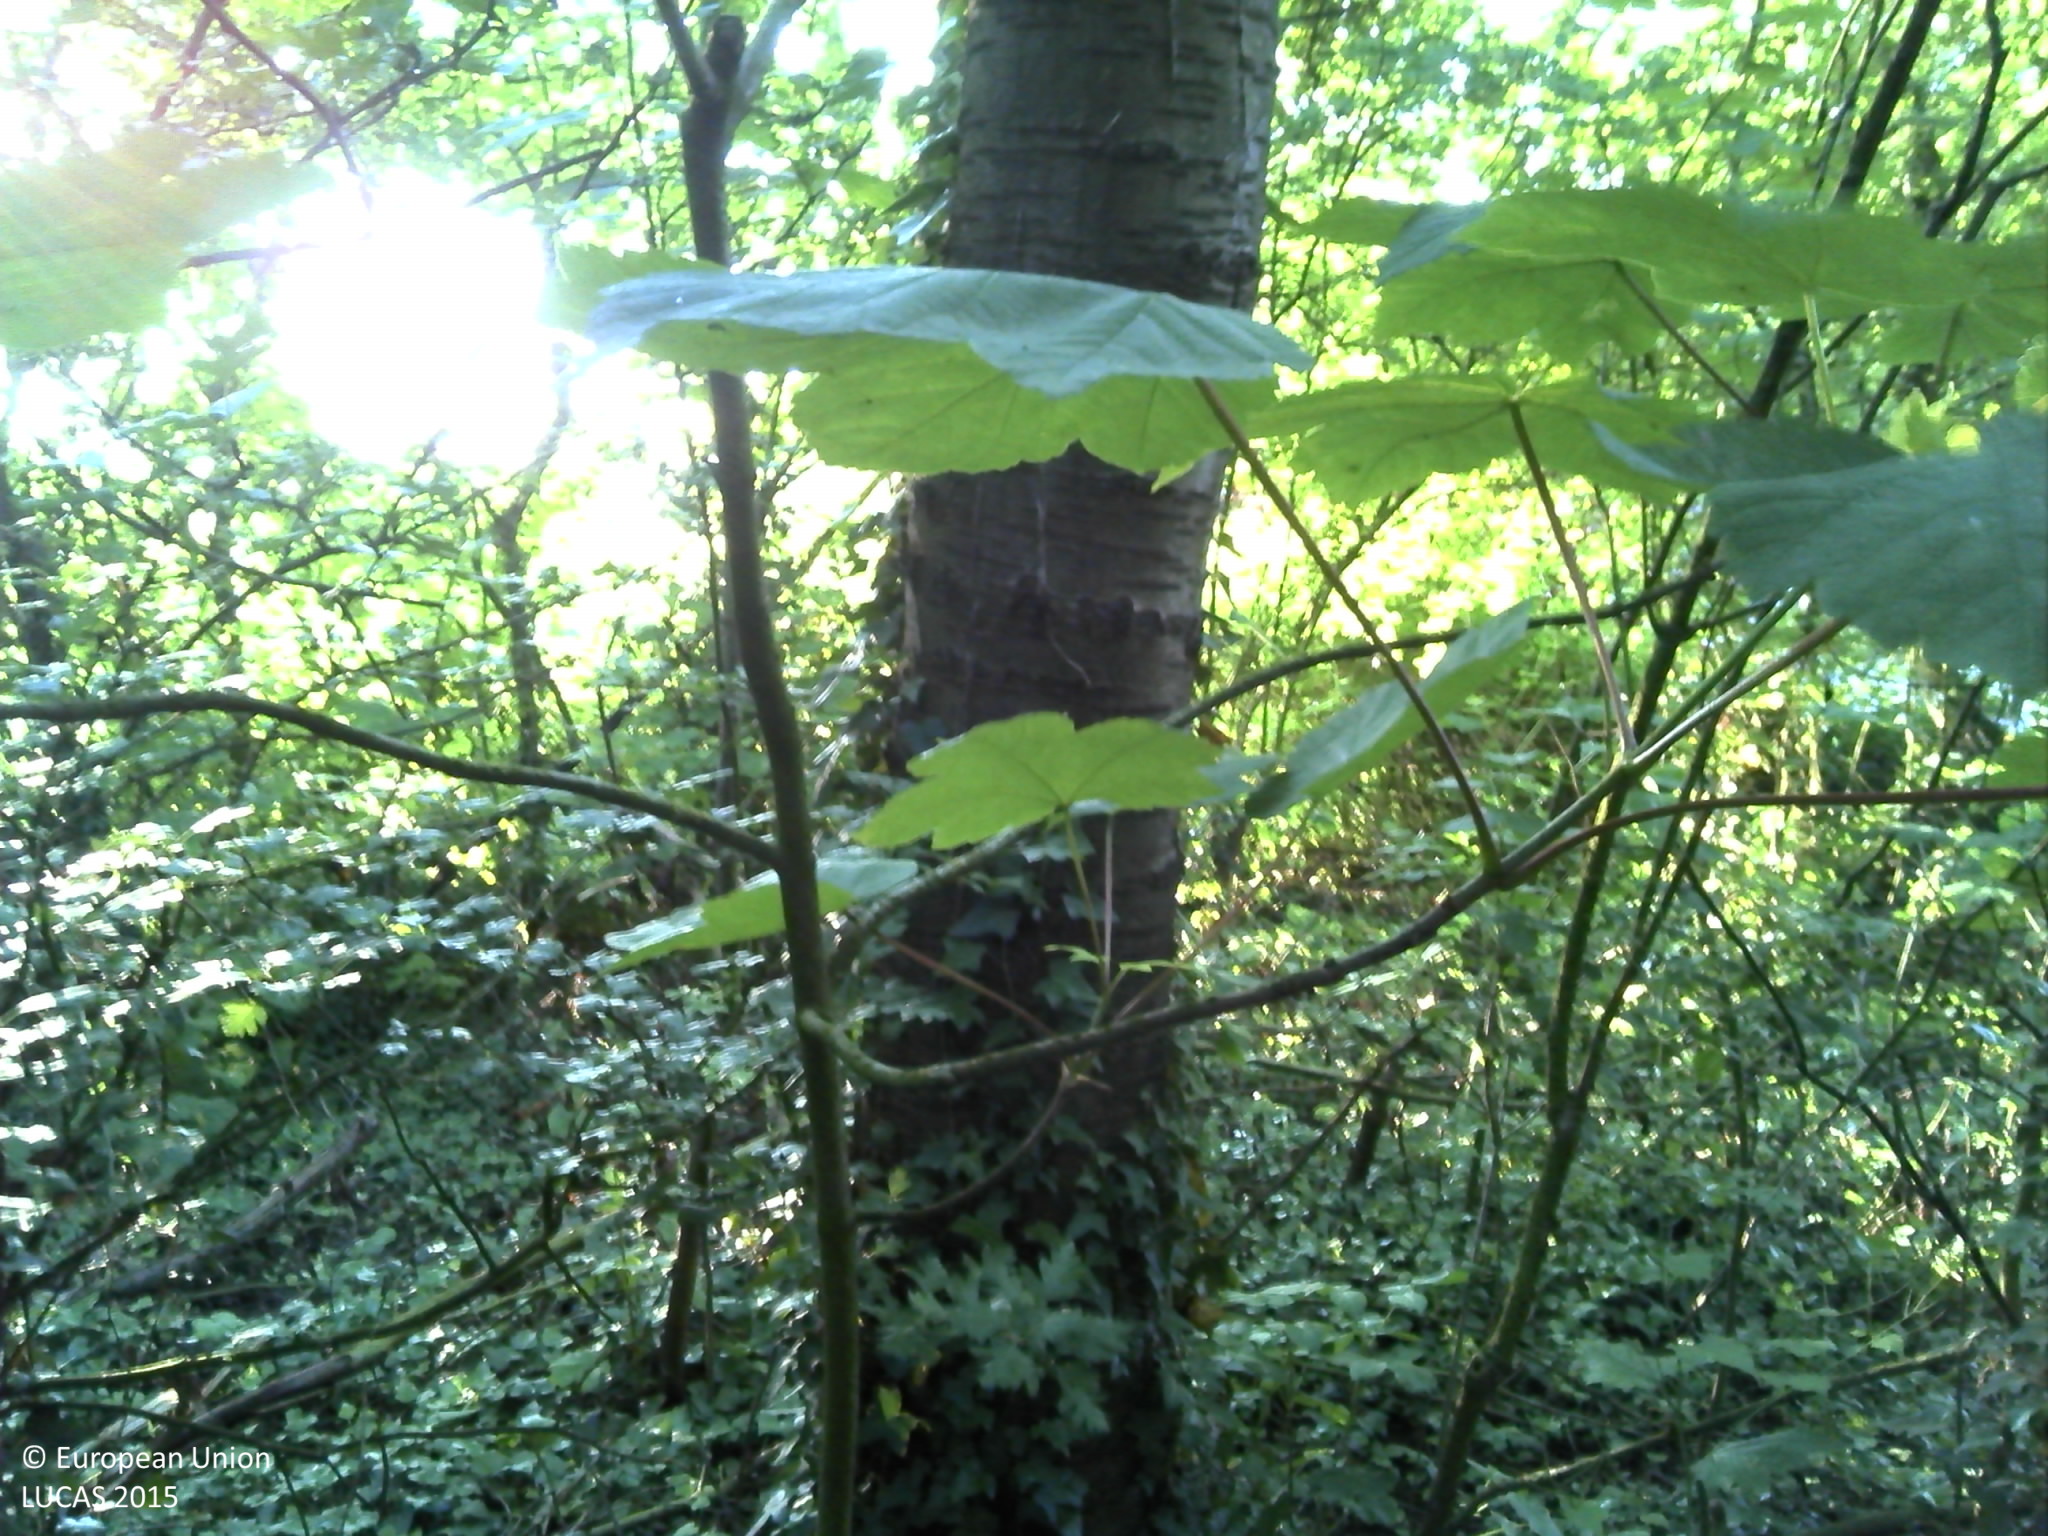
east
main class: Woodland
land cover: Broadleaved woodland
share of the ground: > 75 %
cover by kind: broadleaved forest trees 80 %, herbaceous plants 20 %
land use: Forestry
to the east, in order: Broadleaved woodland; Artificial constructions in urban areas
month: June
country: FR
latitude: 49.6746
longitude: 1.1235
